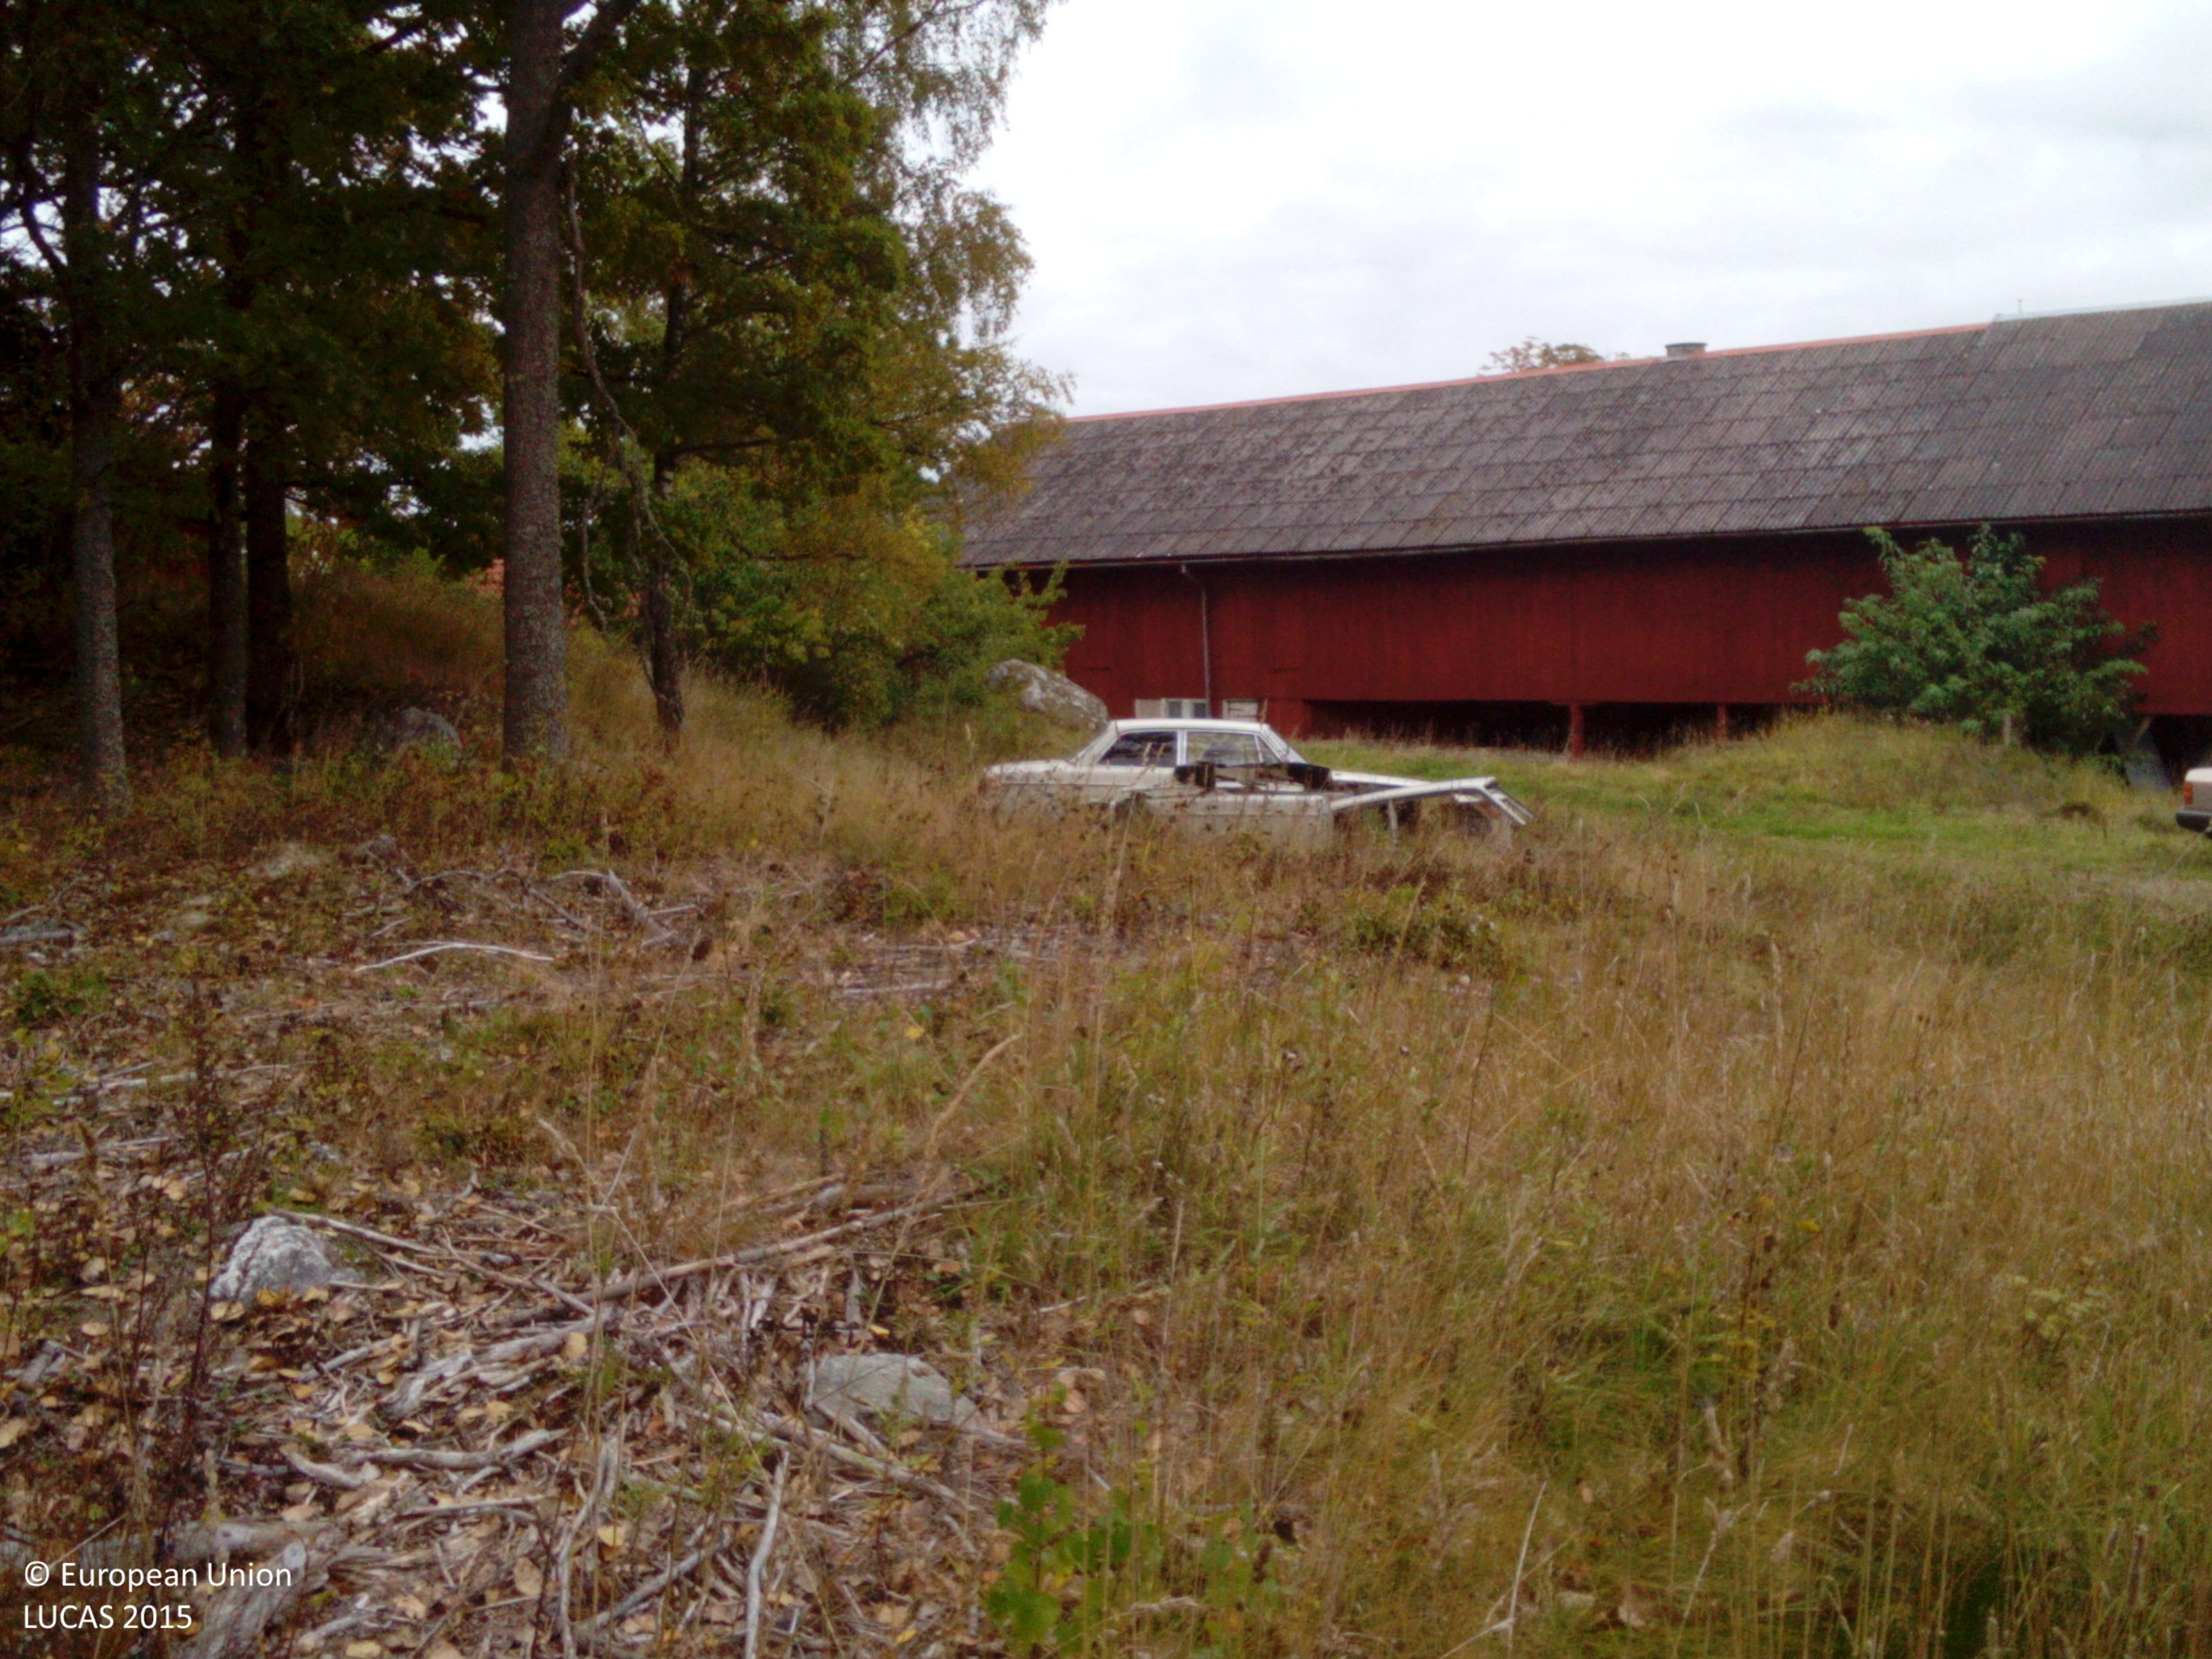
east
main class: Shrubland
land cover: Shrubland with sparse tree cover
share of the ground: 25 - 50 %
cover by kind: shrubs 45 %, herbaceous plants 40 %, broadleaved forest trees 5 %
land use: Semi-natural and natural areas not in use
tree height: < 5 m
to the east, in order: Shrubland with sparse tree cover; Broadleaved woodland; Artificial constructions in urban areas; Grassland without tree/shrub cover; Broadleaved woodland; Grassland without tree/shrub cover; Paved roads, cycling and walking lanes; Grassland without tree/shrub cover
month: October
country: SE
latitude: 58.8569
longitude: 16.4957
